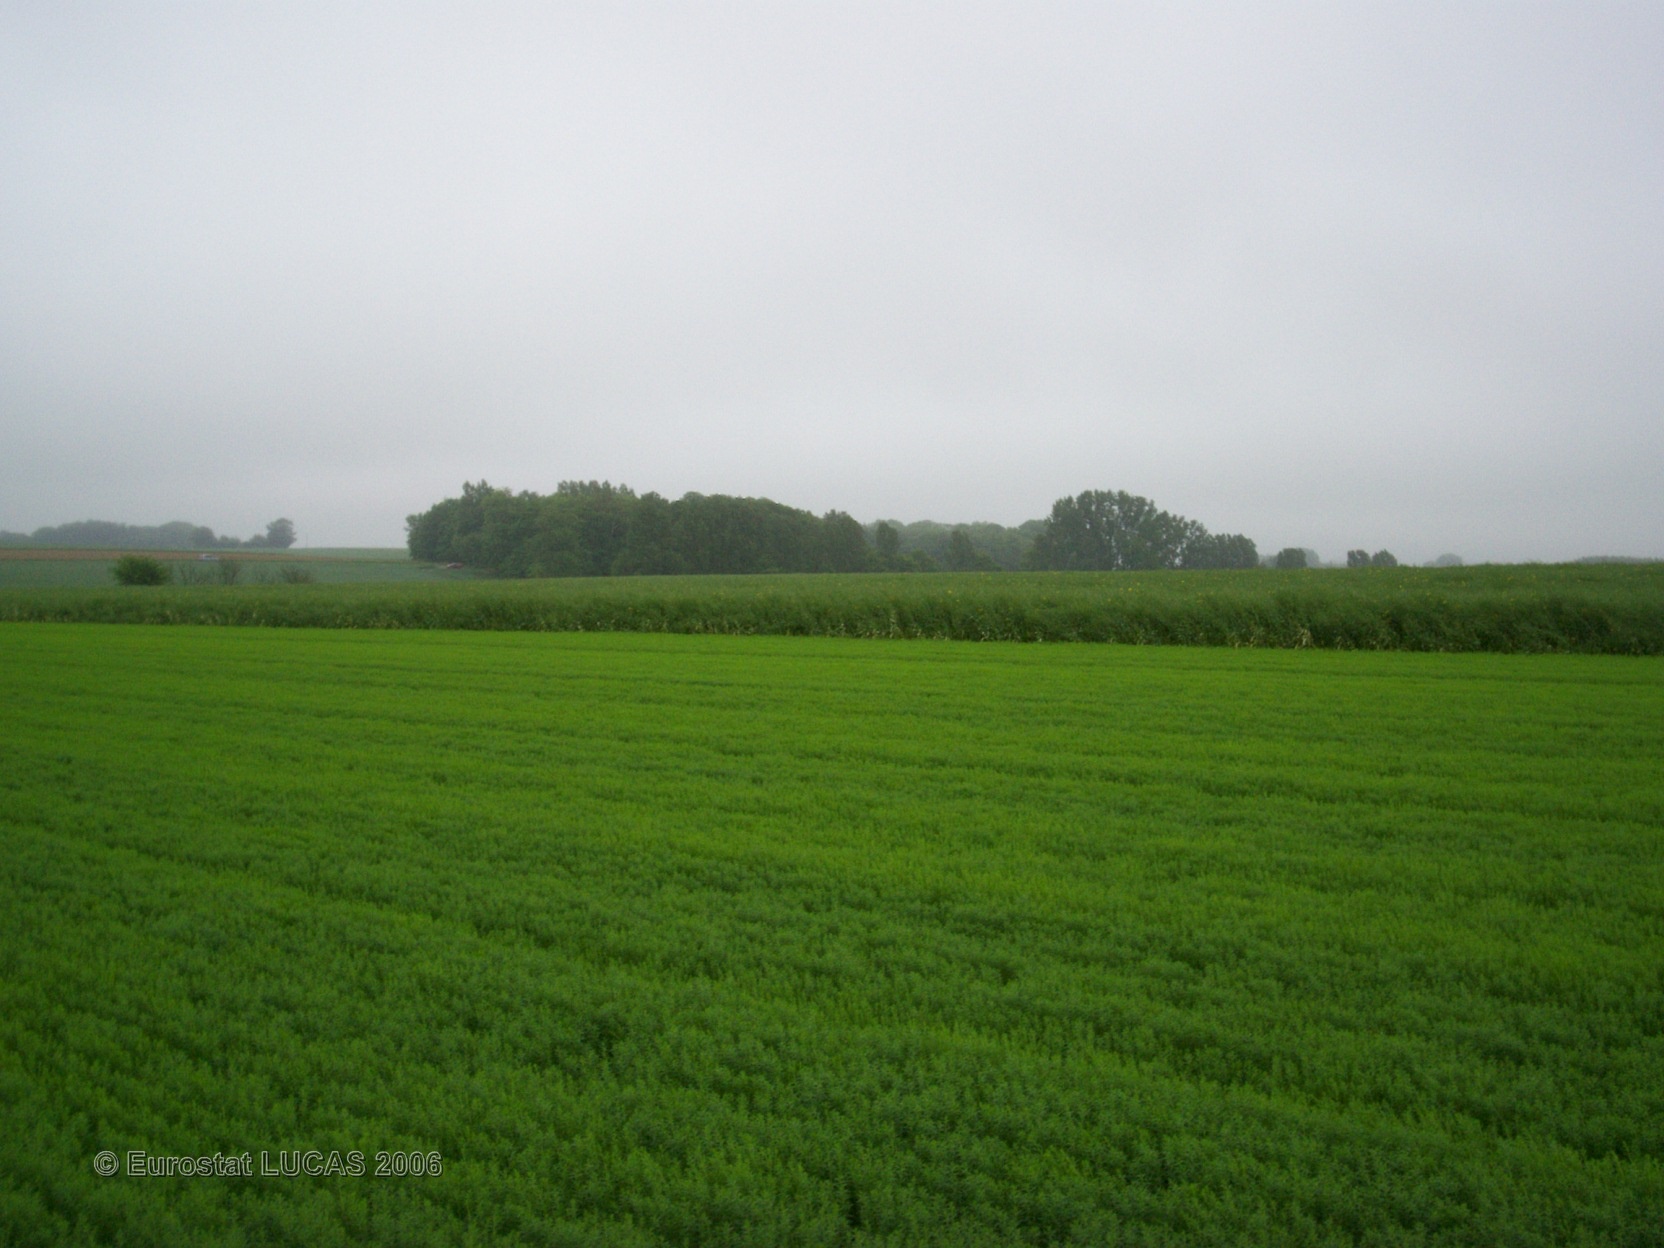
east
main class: Cropland
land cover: Other fibre and oleaginous crops
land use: Agriculture (excluding fallow land and kitchen gardens)
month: May
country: FR
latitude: 49.6392
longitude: 0.9067
